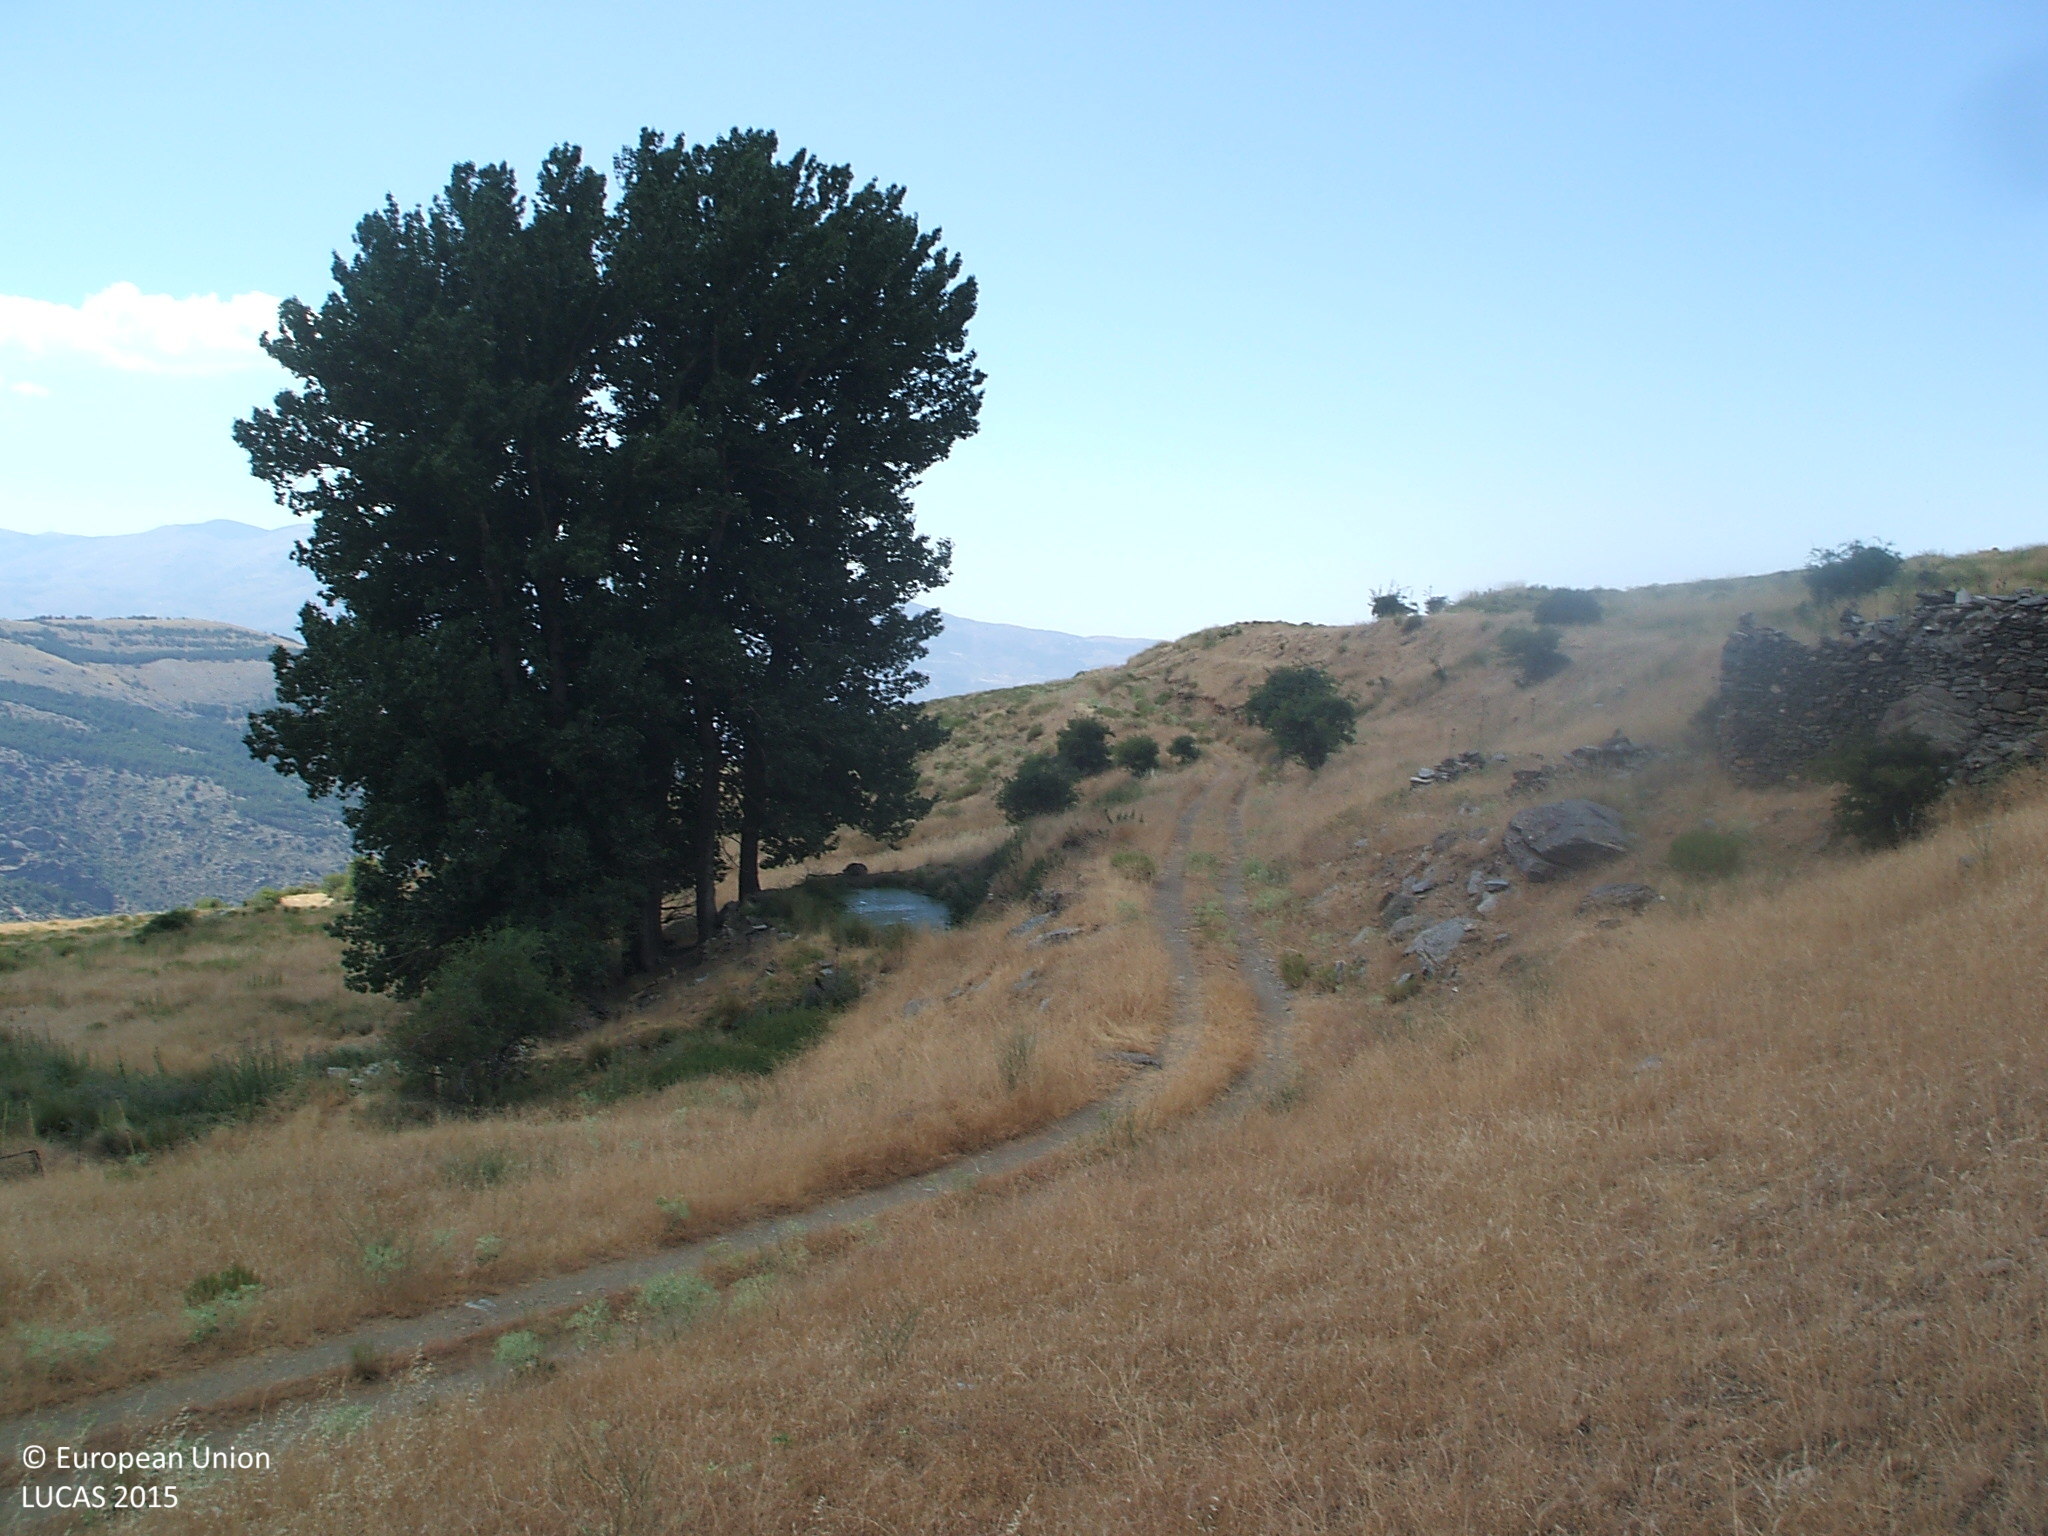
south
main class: Grassland
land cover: Grassland with sparse tree/shrub cover
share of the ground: > 75 %
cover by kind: herbaceous plants 95 %, broadleaved forest trees 5 %
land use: Semi-natural and natural areas not in use
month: July
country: ES
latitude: 37.0692
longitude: -2.8821
